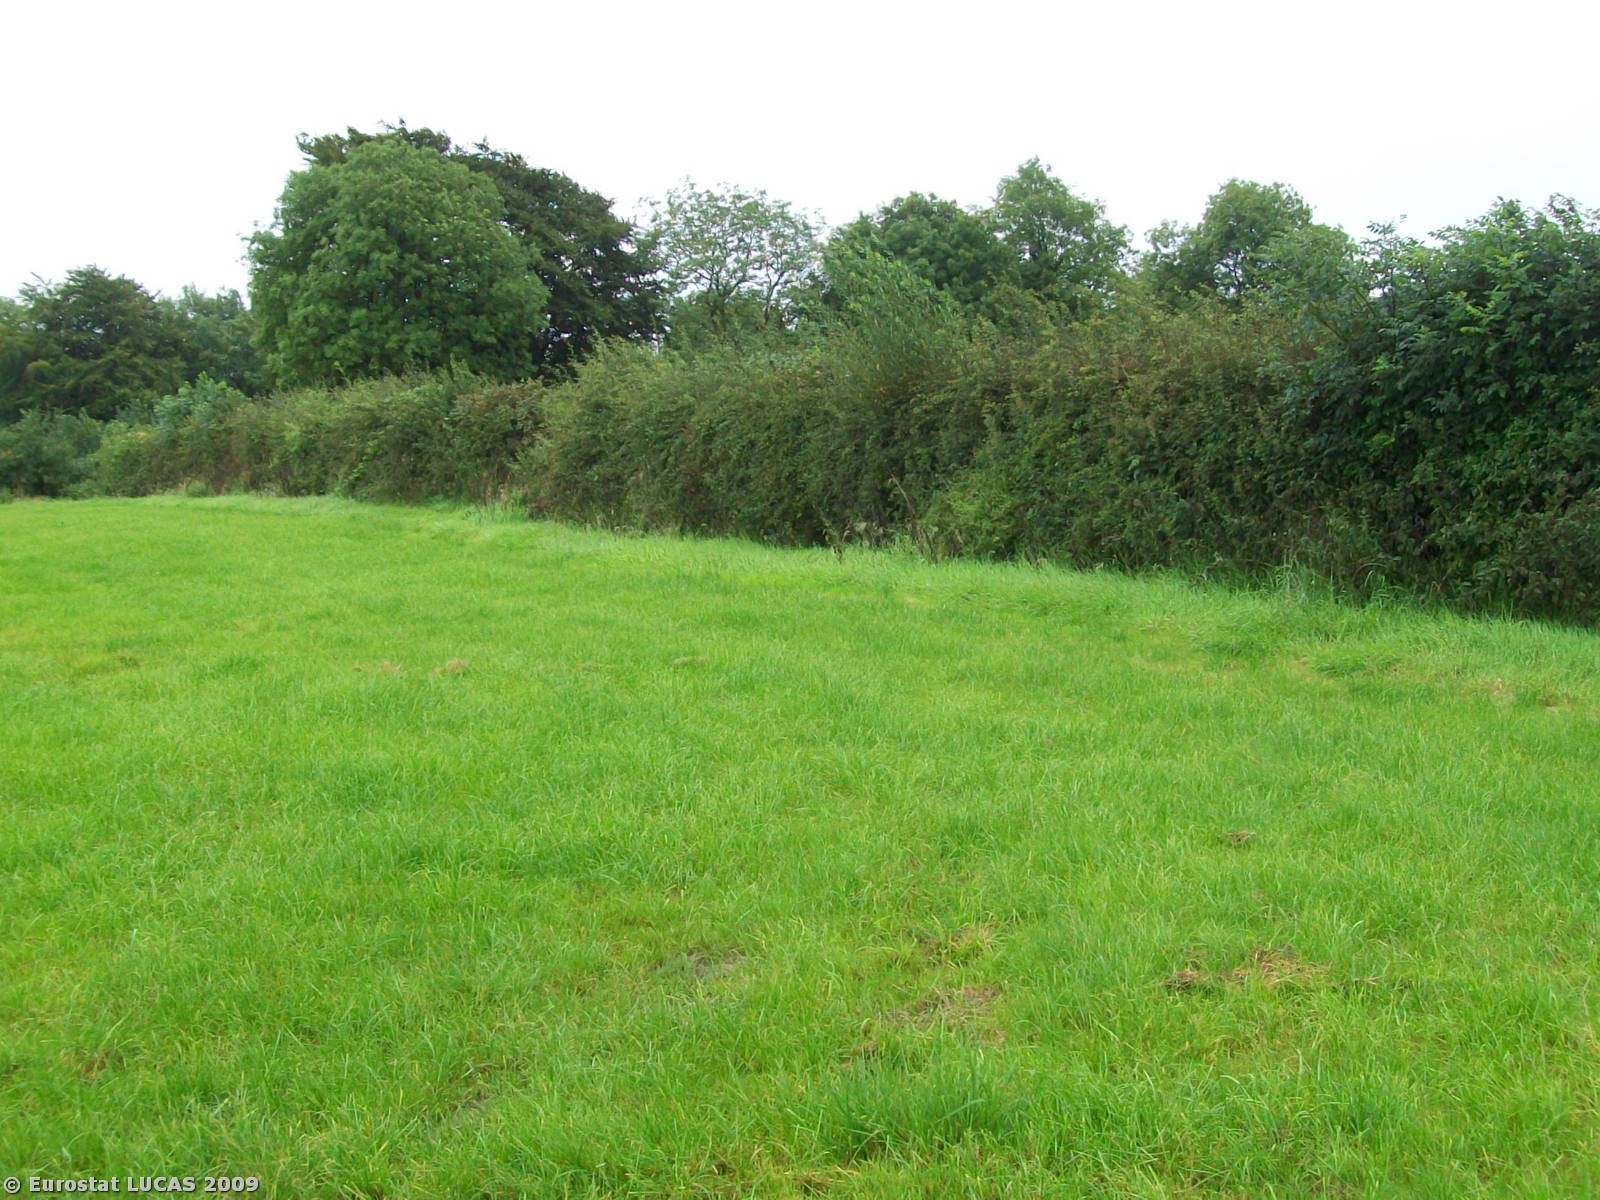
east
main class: Grassland
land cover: Grassland without tree/shrub cover
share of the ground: > 75 %
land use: Agriculture (excluding fallow land and kitchen gardens)
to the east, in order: Grassland without tree/shrub cover; Abandoned hedges; Fences; Electric lines; Grassland without tree/shrub cover; Managed hedges; Broadleaved woodland; Tracks; Managed hedges; Grassland without tree/shrub cover; Fences; Grass margins; Broadleaved woodland; Inland running water; Broadleaved woodland; Fences; Grass margins; Paved roads, cycling and walking lanes
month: August
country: GB
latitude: 54.6089
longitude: -6.1061
